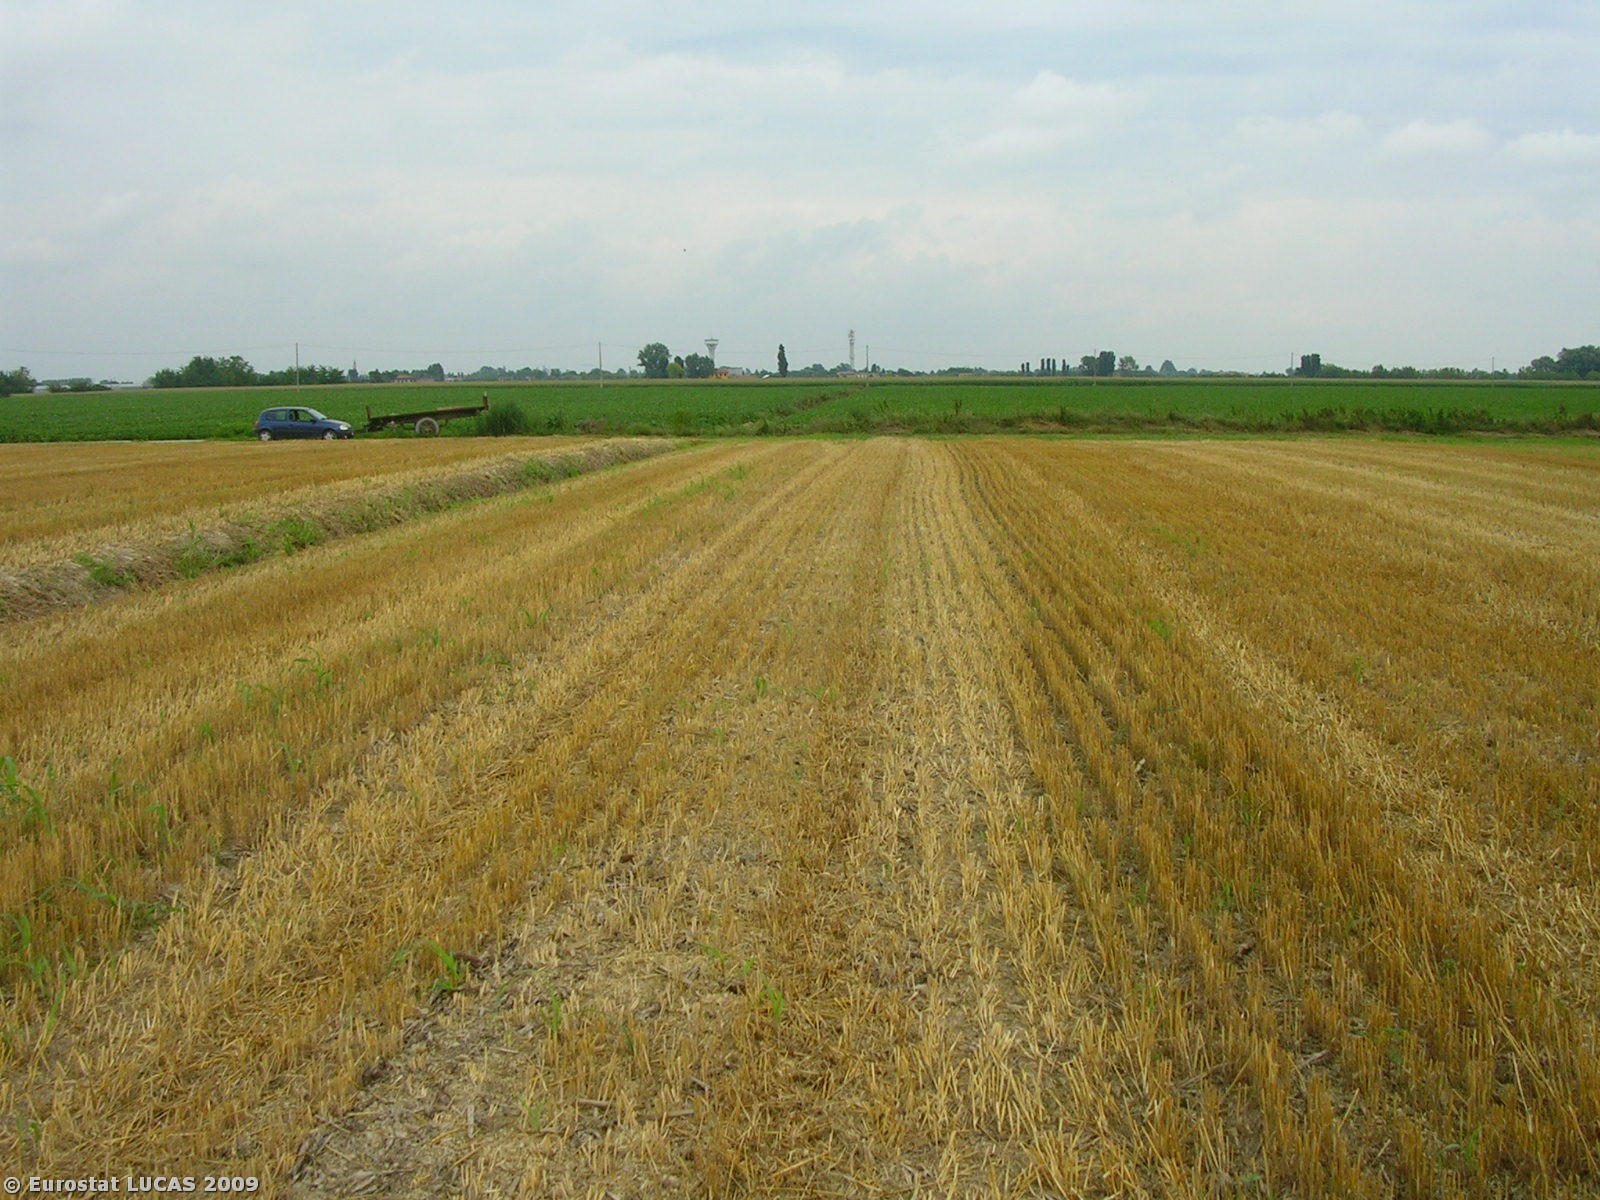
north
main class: Cropland
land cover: Common wheat
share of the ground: > 75 %
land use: Agriculture (excluding fallow land and kitchen gardens)
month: July
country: IT
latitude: 45.2502
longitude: 12.0479
